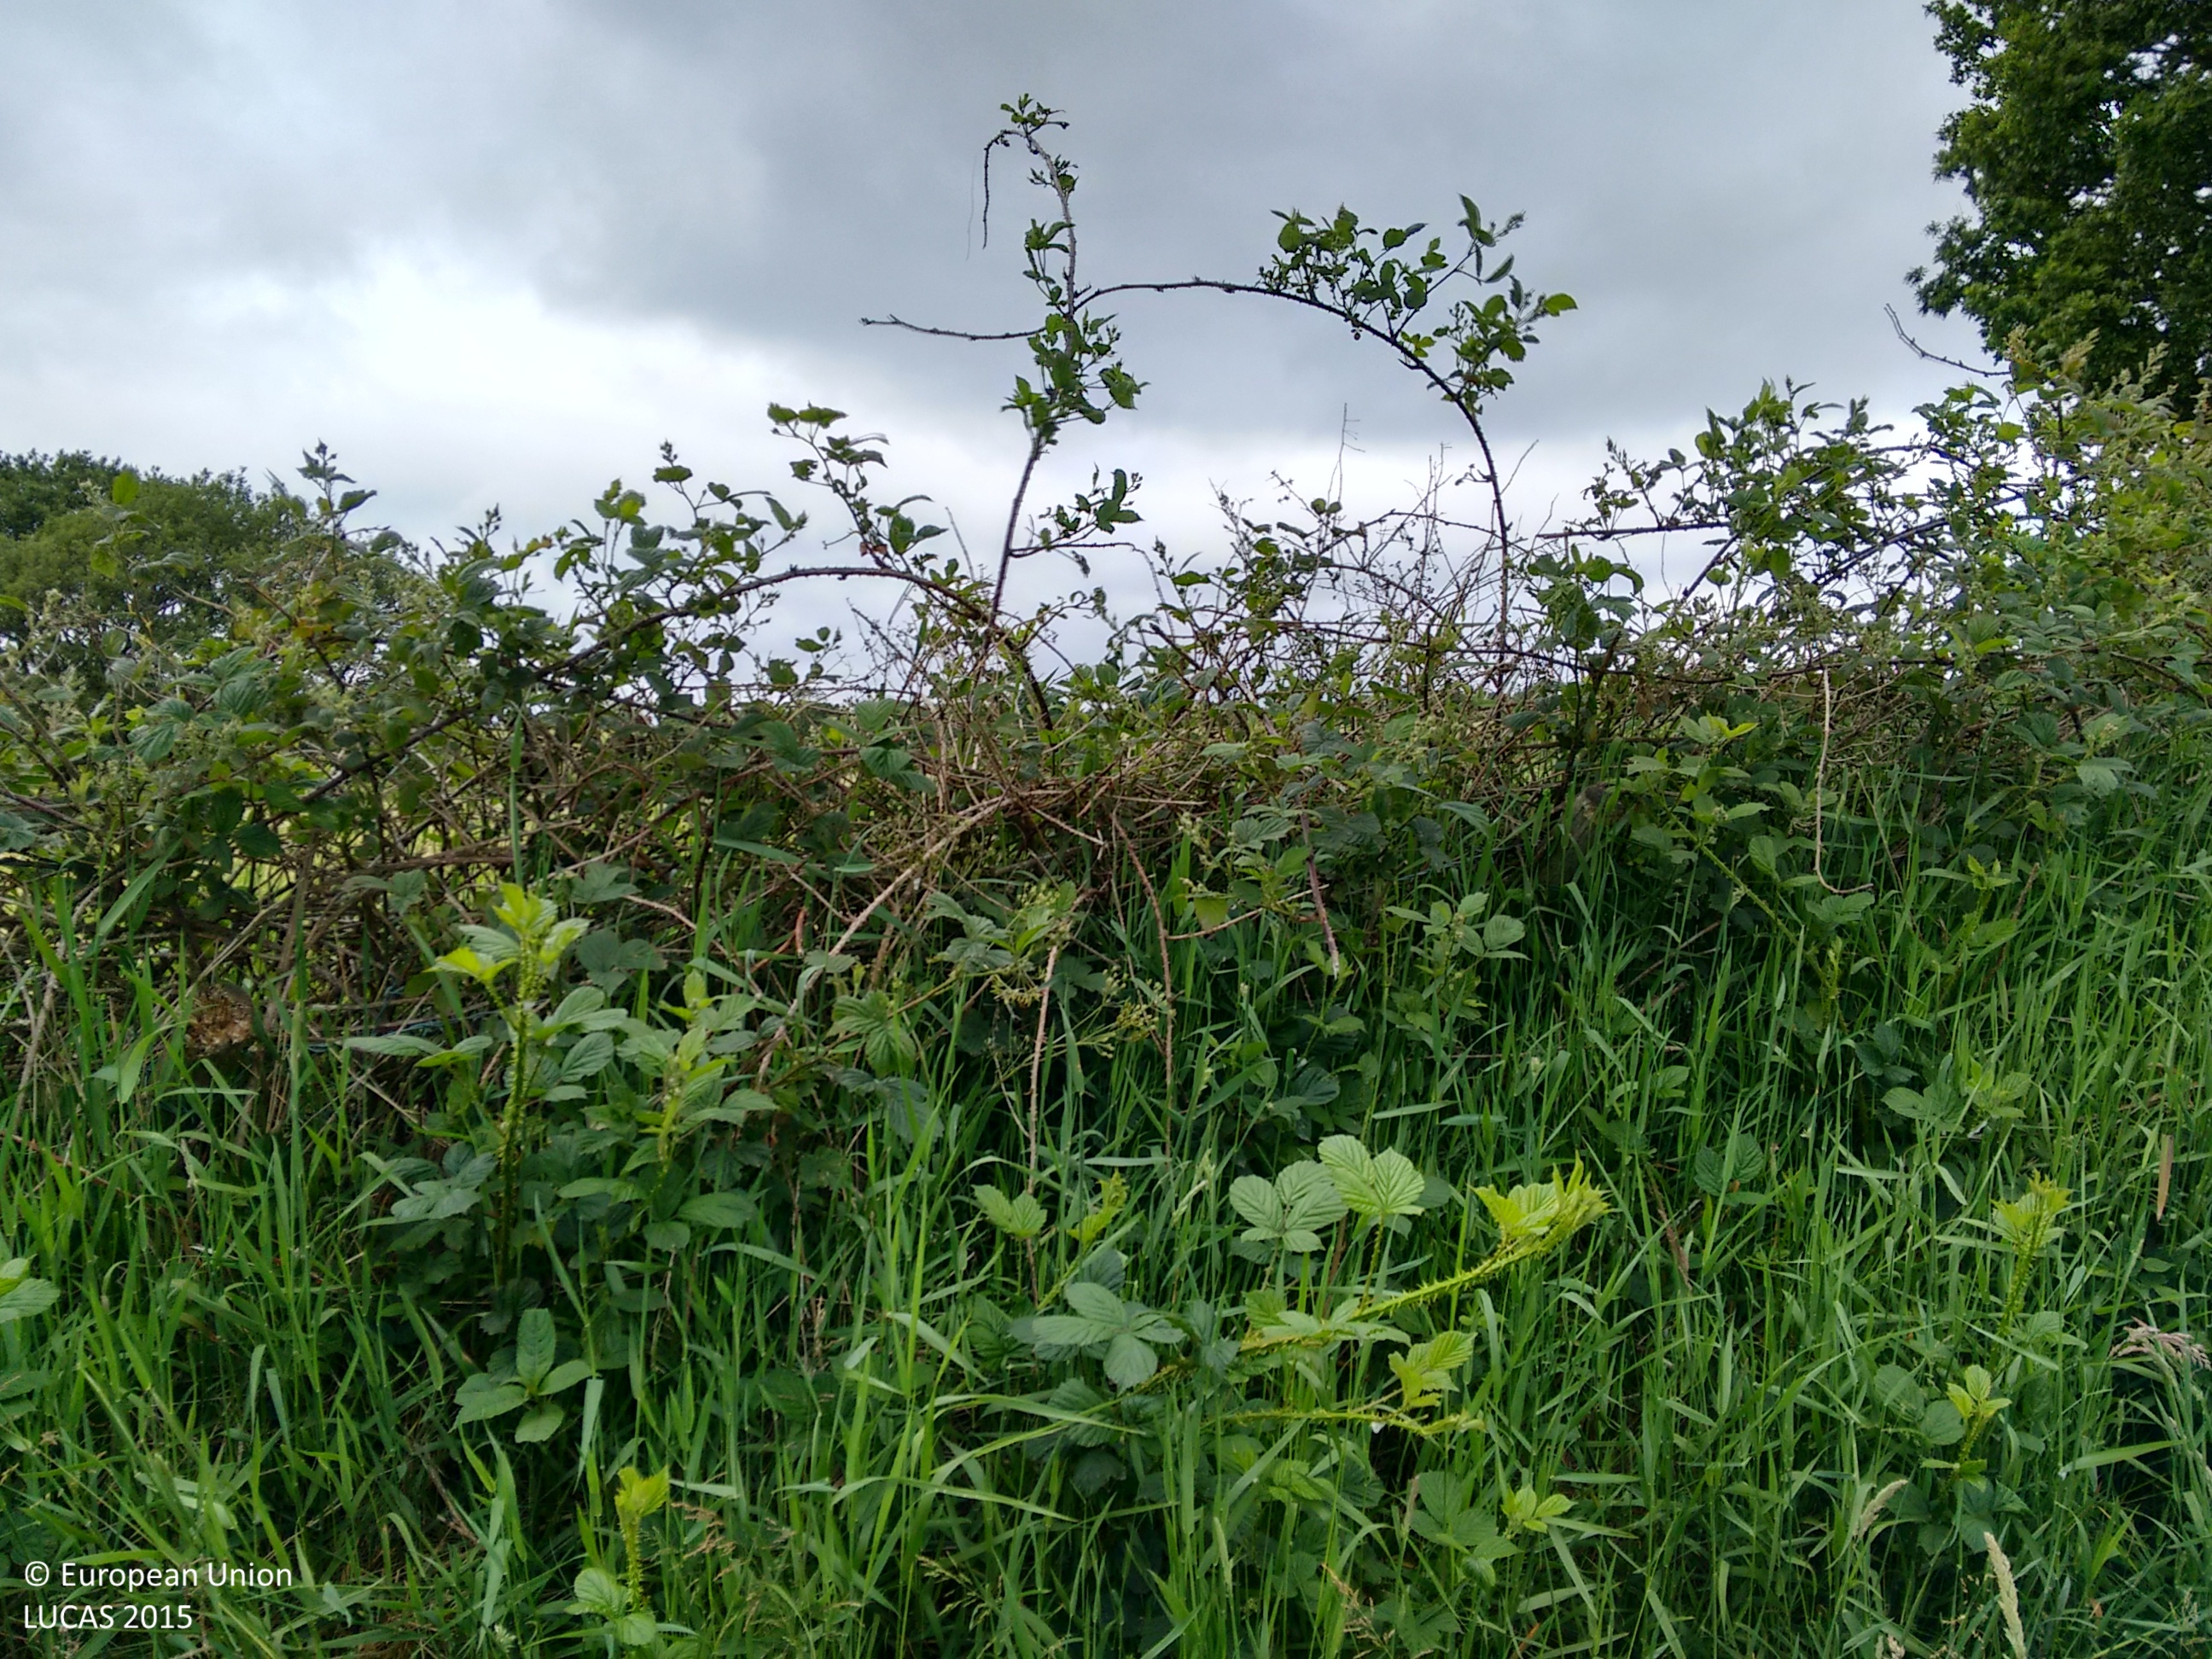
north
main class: Grassland
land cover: Grassland without tree/shrub cover
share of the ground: > 75 %
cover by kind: herbaceous plants 100 %
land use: Agriculture (excluding fallow land and kitchen gardens)
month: June
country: GB
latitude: 53.5691
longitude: -2.1549
